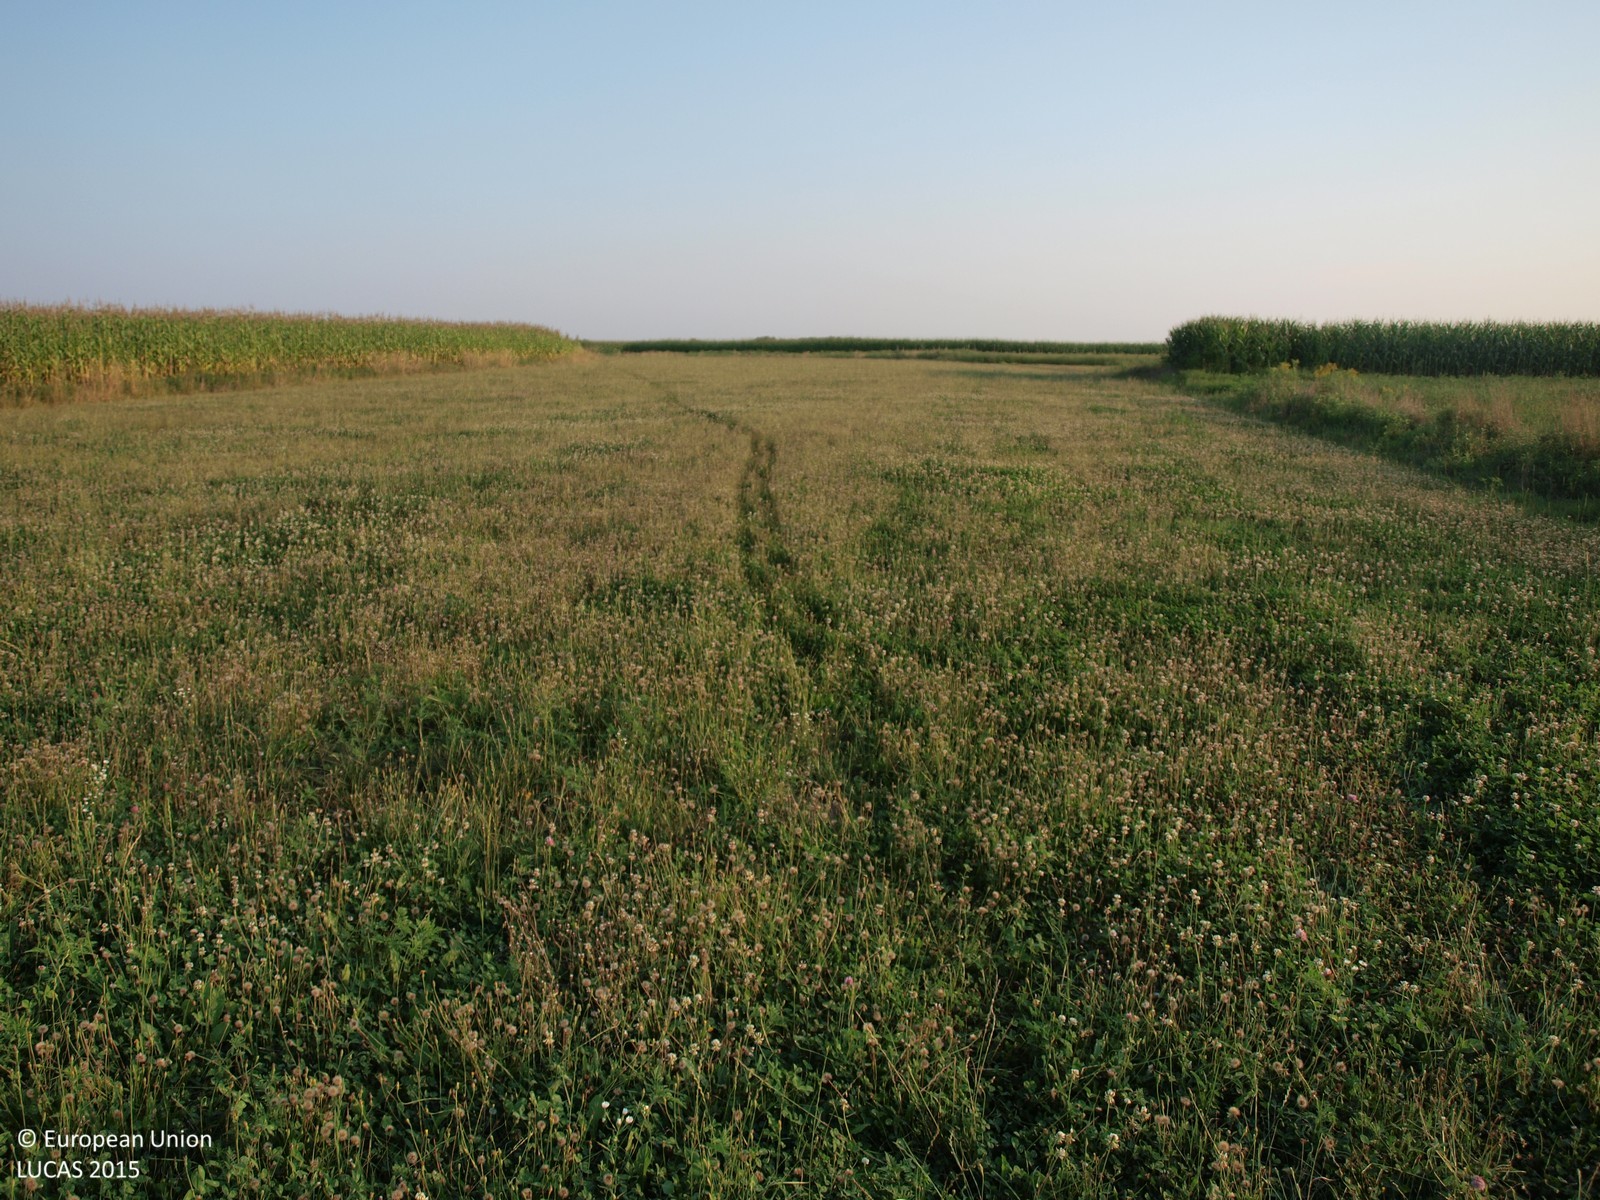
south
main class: Grassland
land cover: Grassland without tree/shrub cover
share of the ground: > 75 %
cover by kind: herbaceous plants 100 %
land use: Agriculture (excluding fallow land and kitchen gardens)
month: August
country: HR
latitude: 45.8282
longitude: 16.4999
